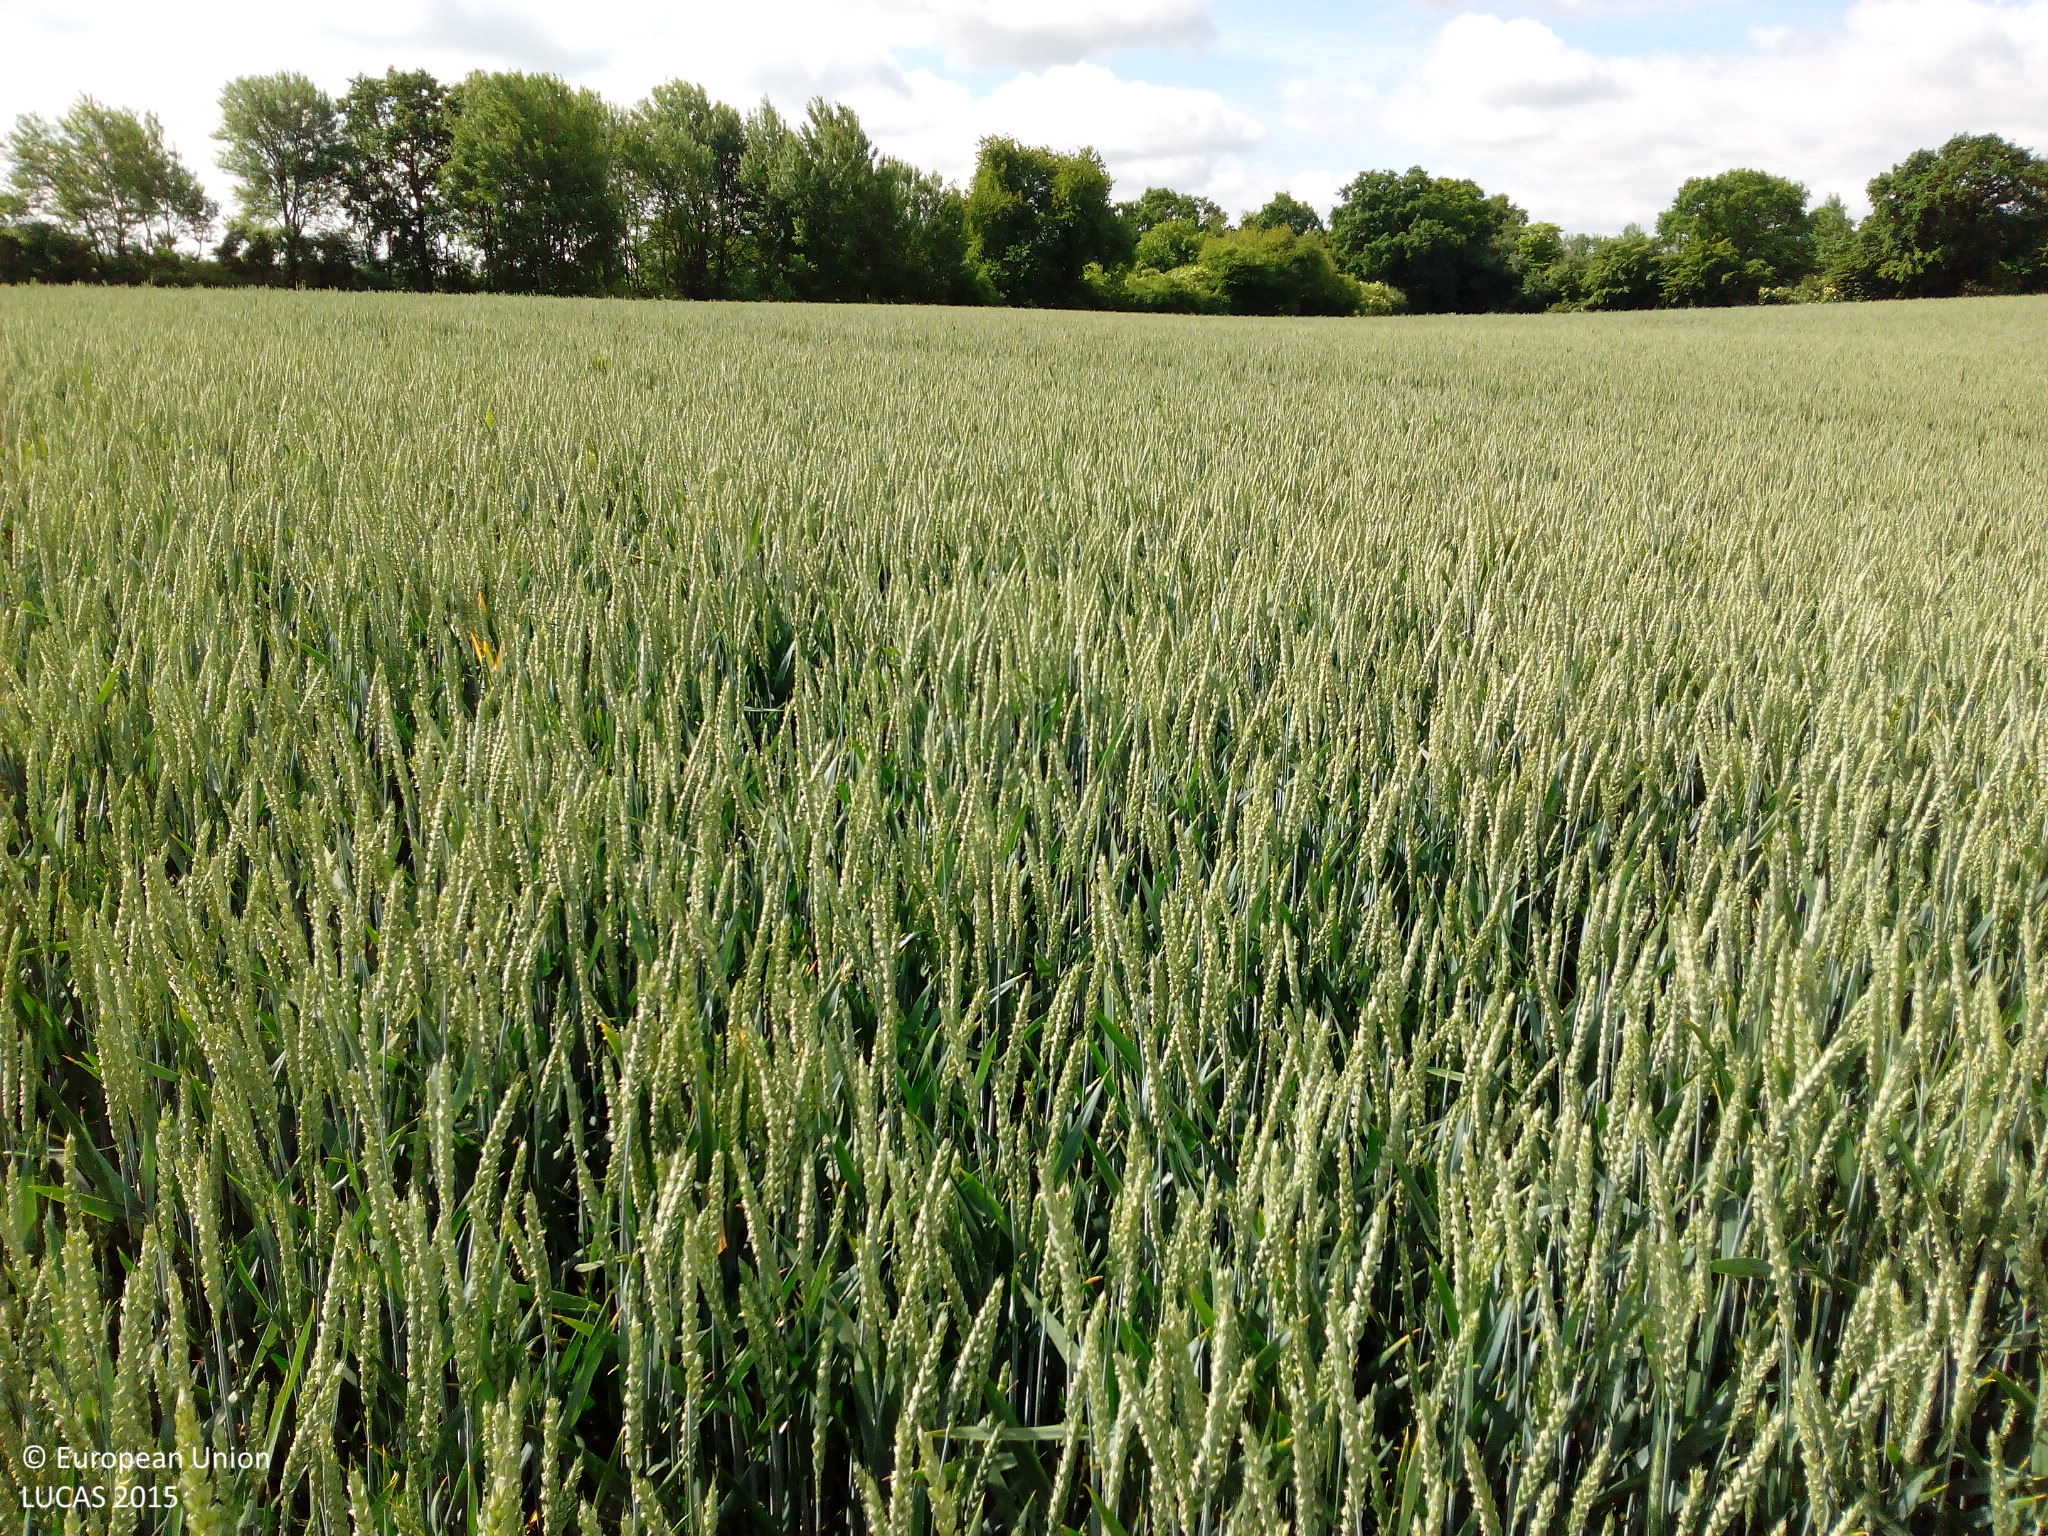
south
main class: Cropland
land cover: Common wheat
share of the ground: > 75 %
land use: Agriculture (excluding fallow land and kitchen gardens)
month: June
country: DE
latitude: 53.7561
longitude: 11.1370
